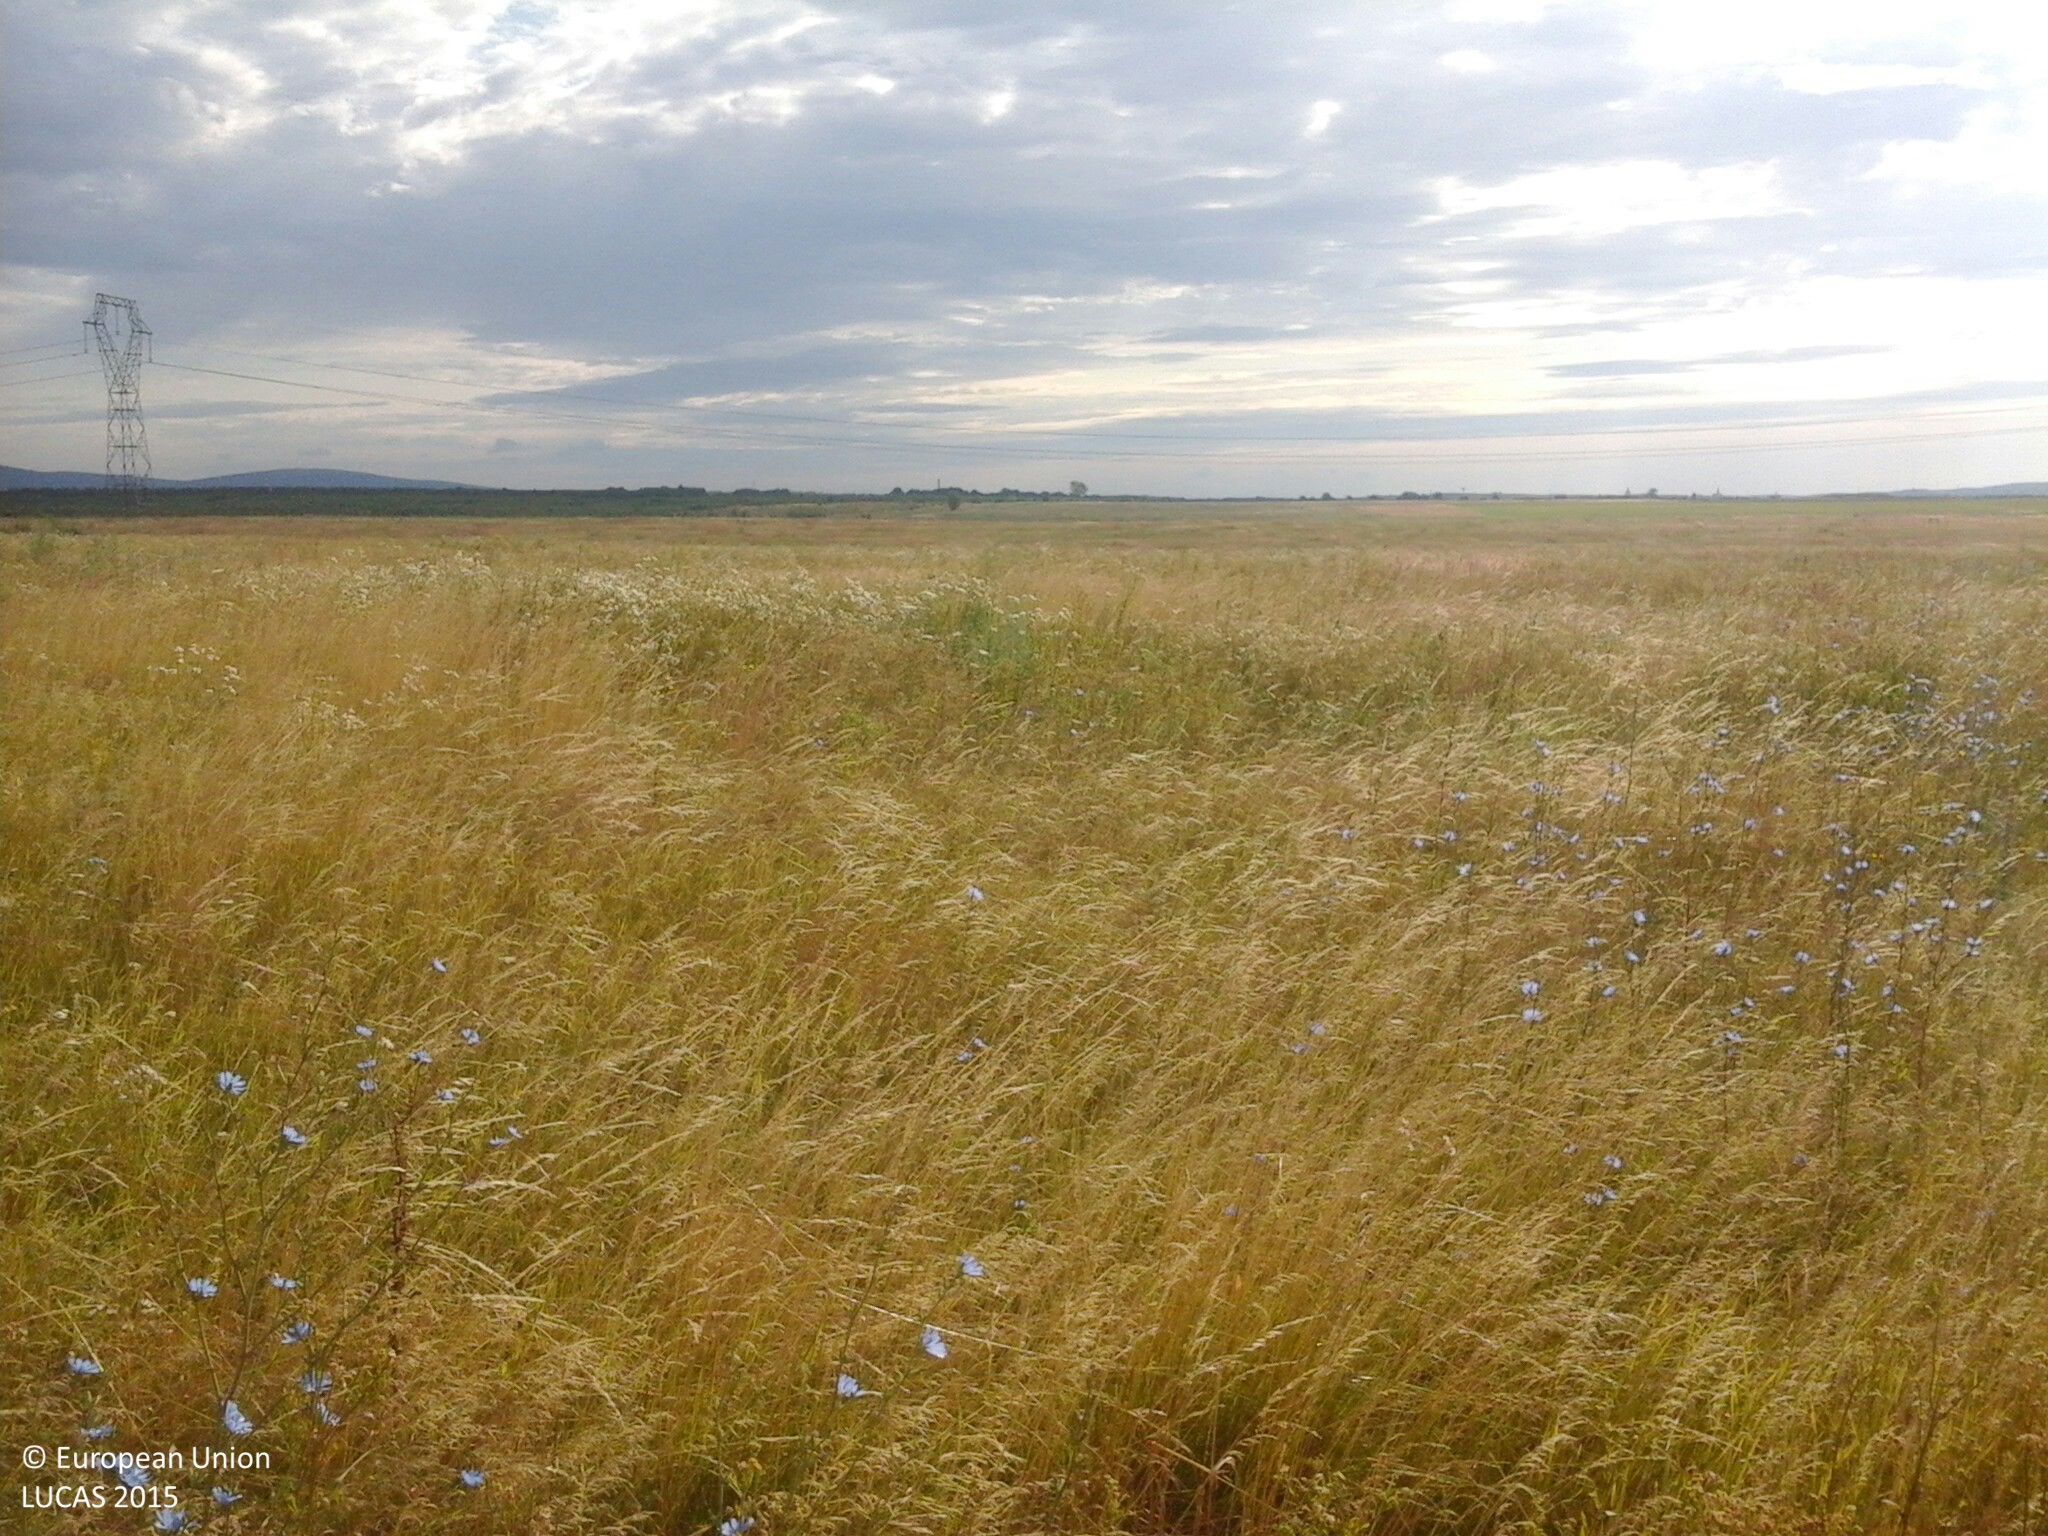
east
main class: Grassland
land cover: Grassland without tree/shrub cover
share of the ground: > 75 %
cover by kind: herbaceous plants 100 %
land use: Agriculture (excluding fallow land and kitchen gardens)
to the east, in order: Grassland without tree/shrub cover
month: July
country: HU
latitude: 47.1397
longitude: 17.9602
